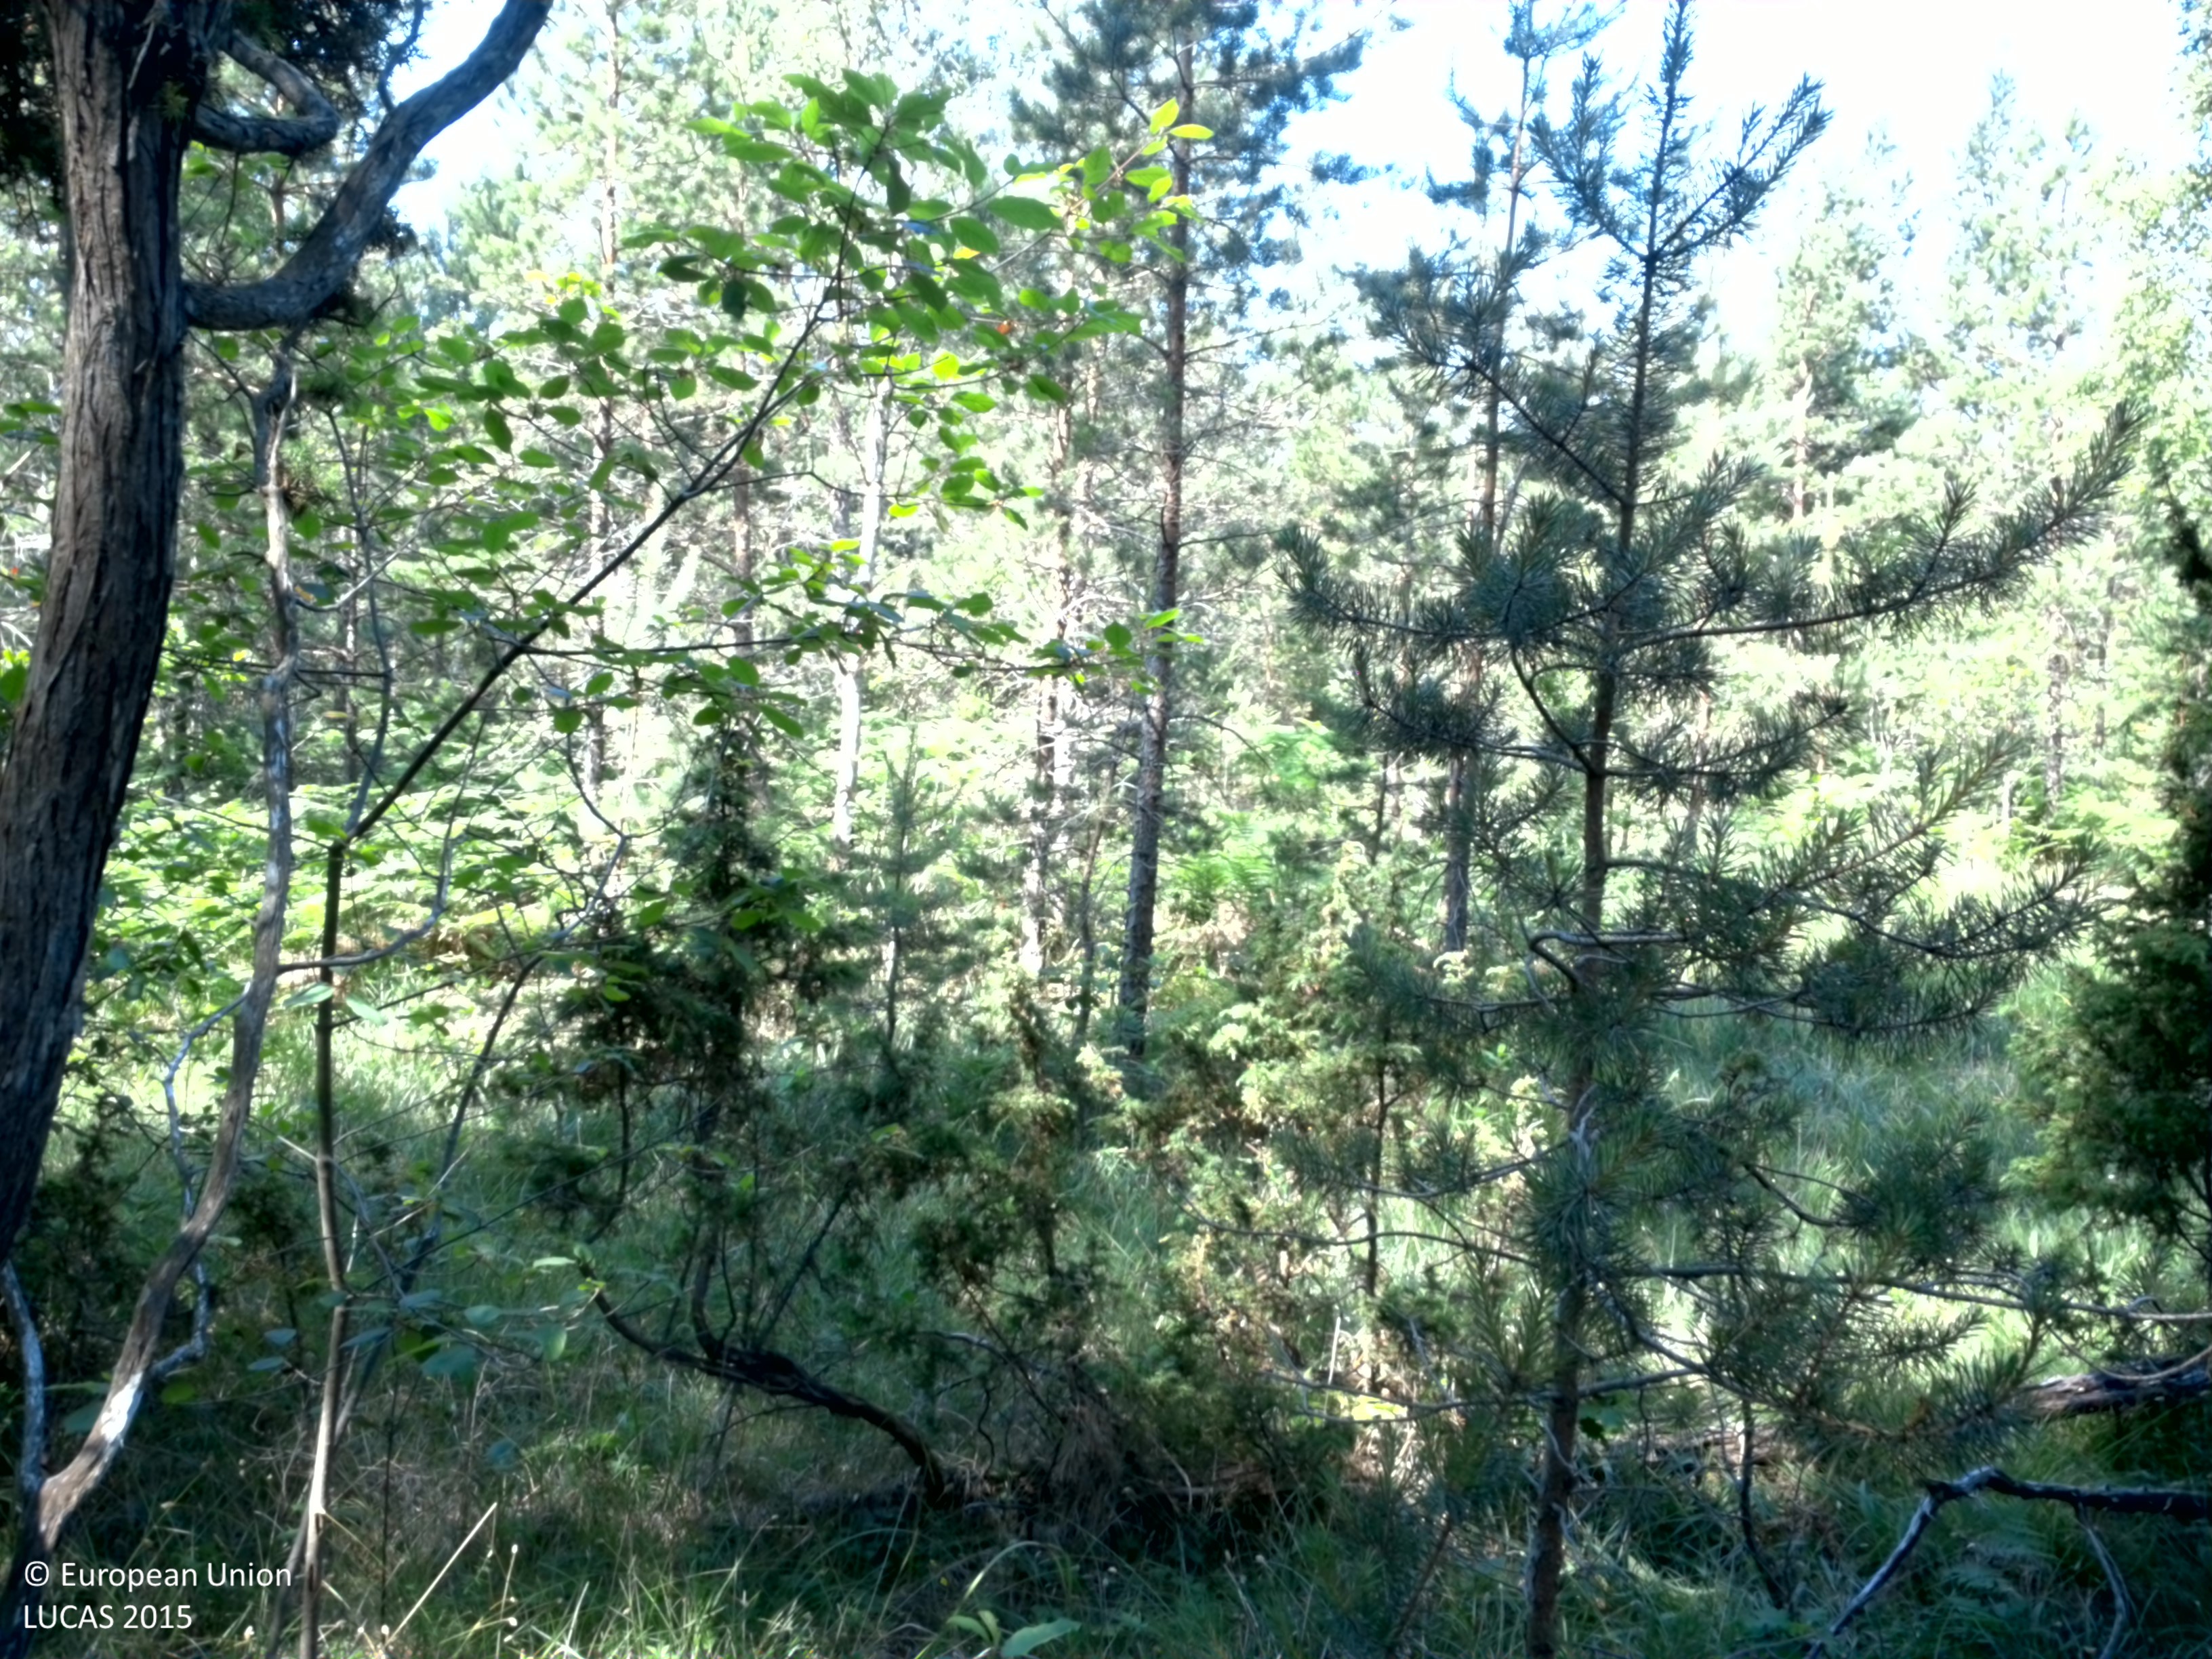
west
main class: Woodland
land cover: Pine dominated coniferous woodland
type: hemiboreal forest and nemoral coniferous forest and mixed broadleaved-coniferous forest
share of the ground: > 75 %
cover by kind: coniferous forest trees 70 %, broadleaved forest trees 15 %, shrubs 15 %
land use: Forestry
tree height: > 5 m
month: July
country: SE
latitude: 57.7649
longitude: 18.5640
